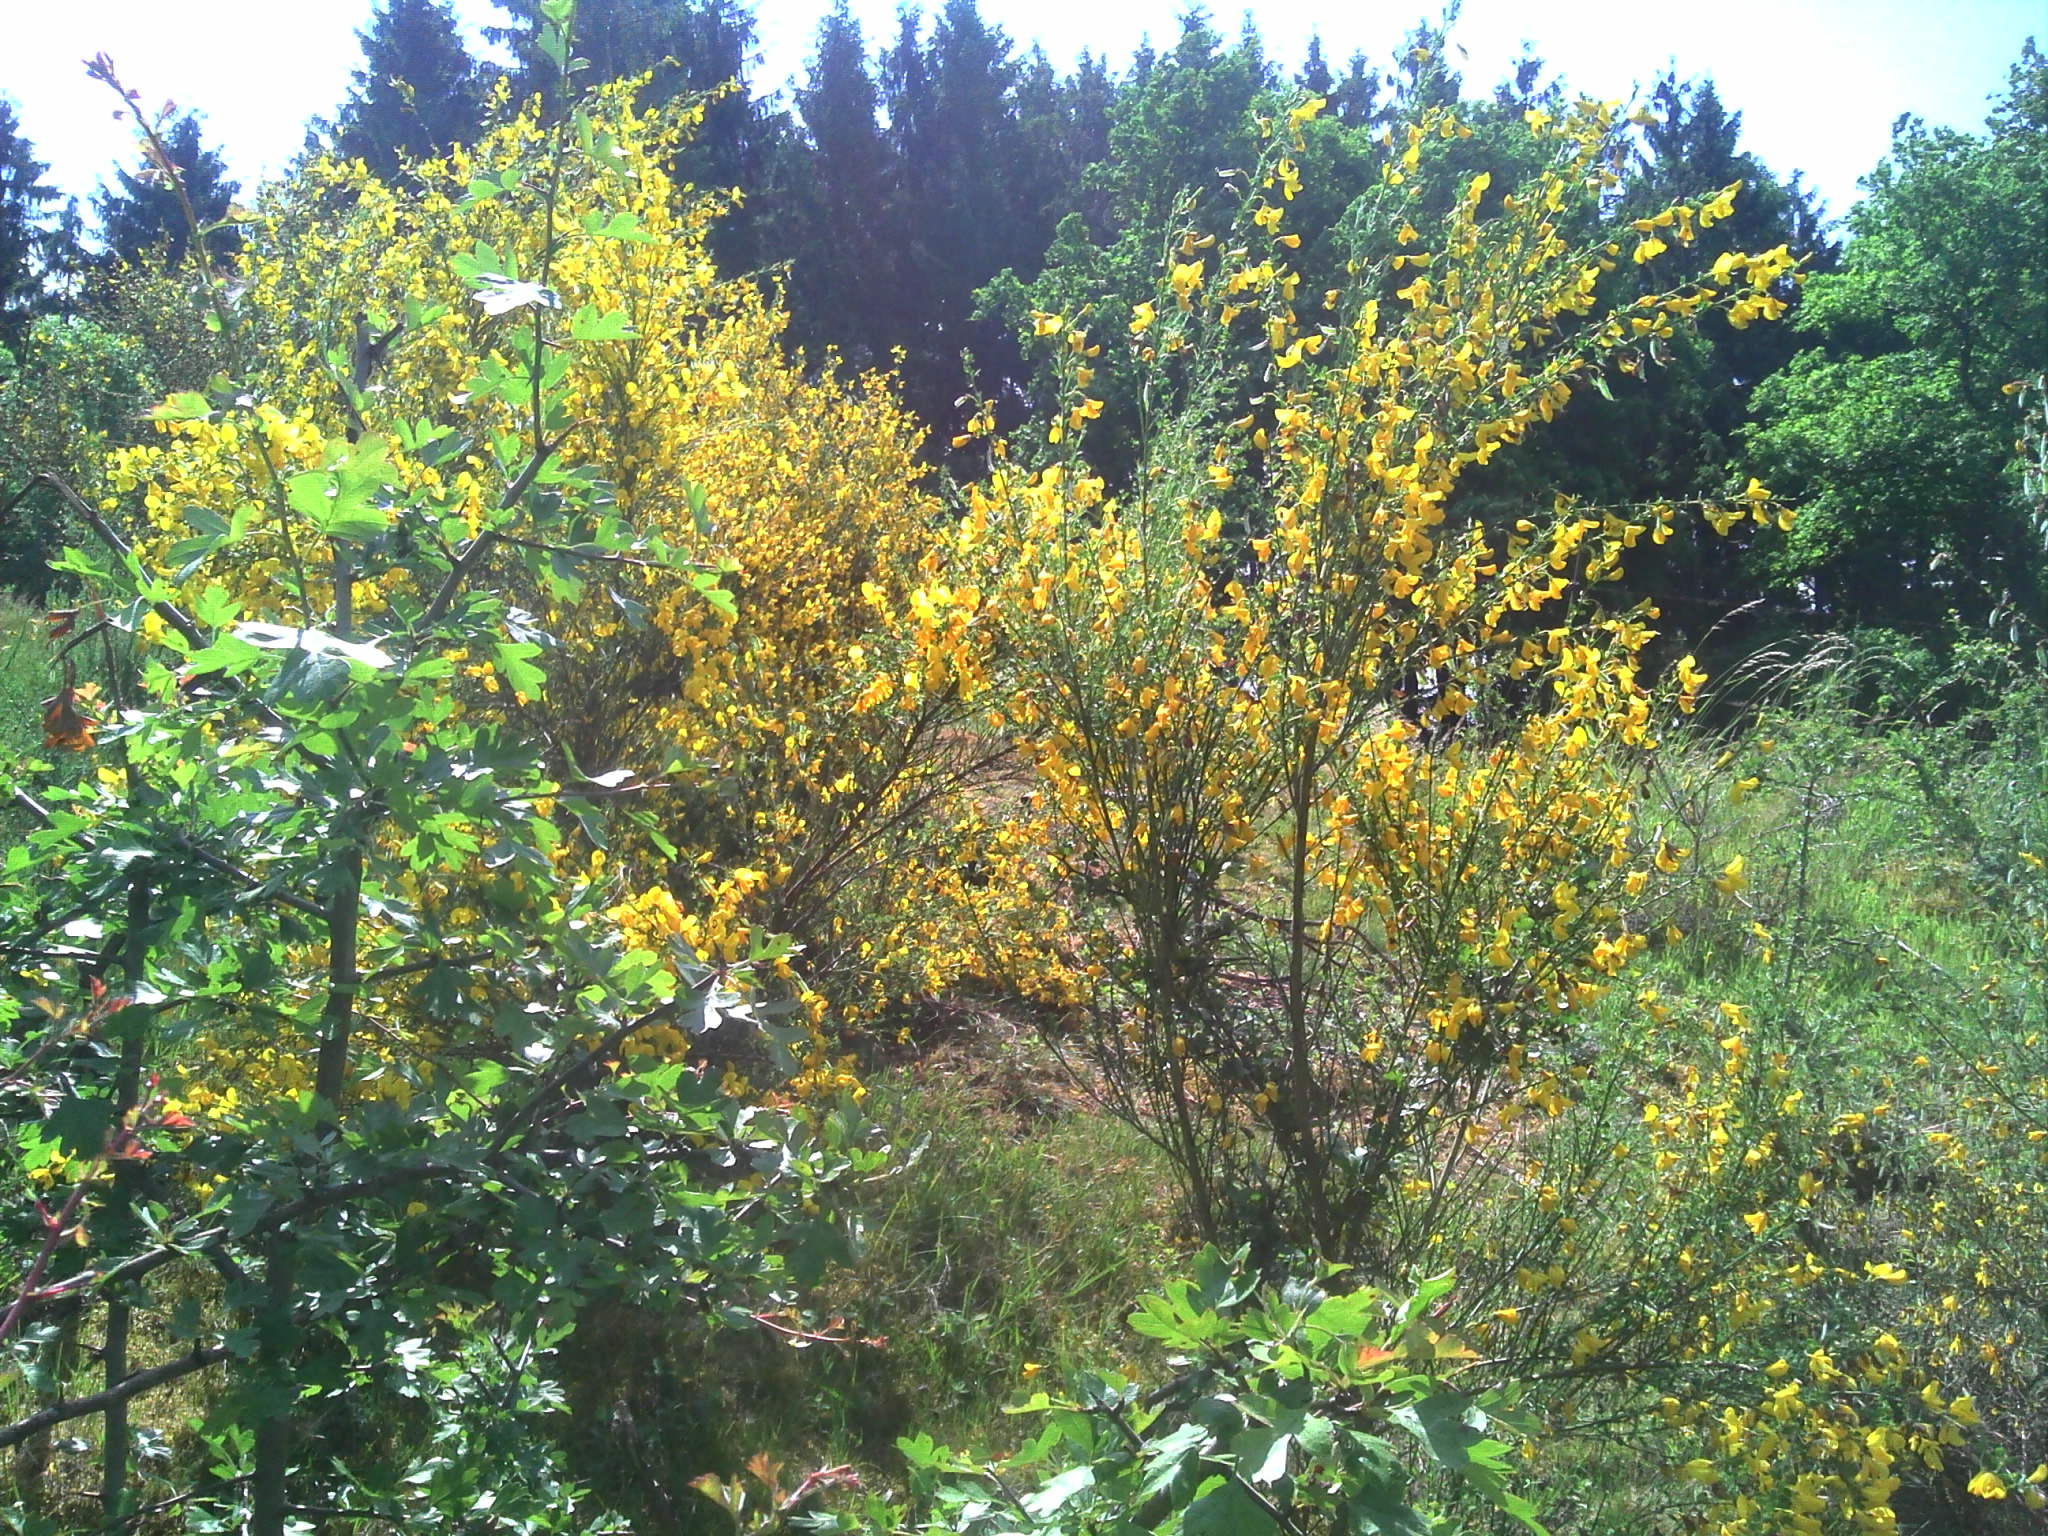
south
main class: Shrubland
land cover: Shrubland without tree cover
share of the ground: > 75 %
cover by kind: shrubs 60 %, herbaceous plants 40 %
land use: Agriculture (excluding fallow land and kitchen gardens)
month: June
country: BE
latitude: 50.2865
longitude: 5.3243
